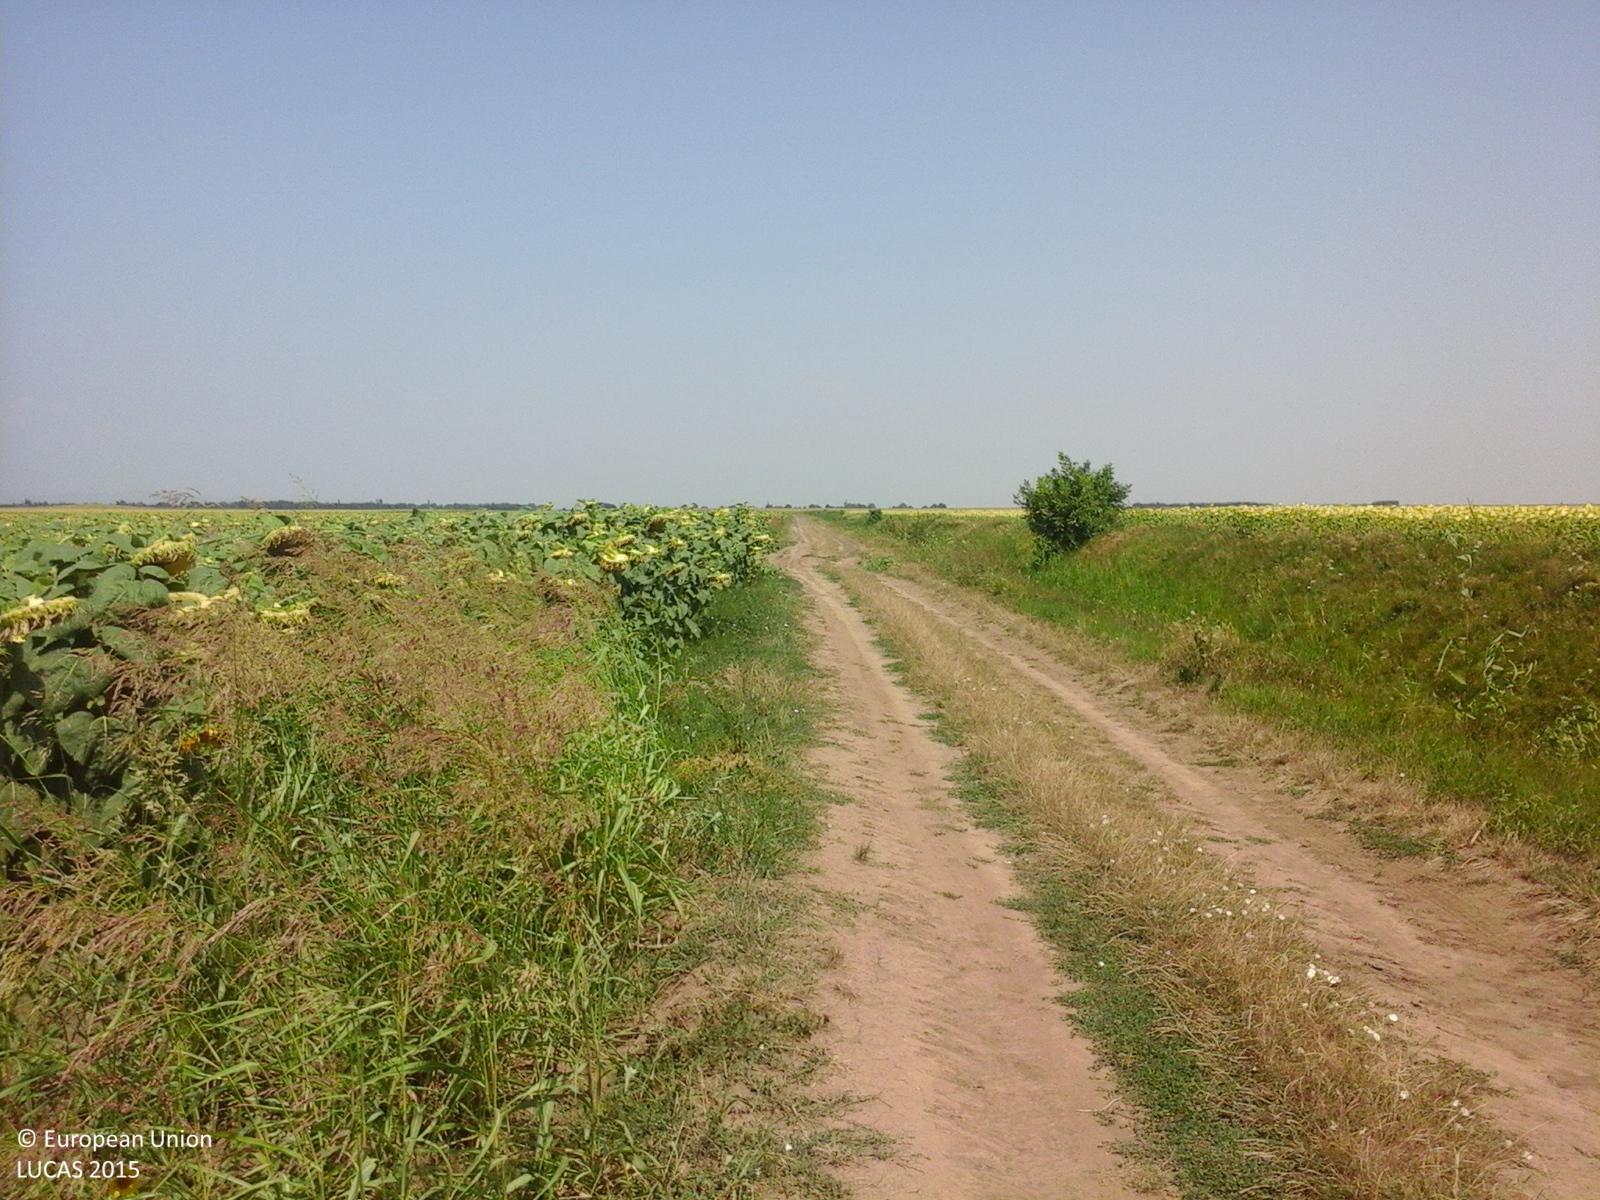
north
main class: Cropland
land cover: Sunflower
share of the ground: > 75 %
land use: Agriculture (excluding fallow land and kitchen gardens)
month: August
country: RO
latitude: 44.9325
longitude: 26.7120
